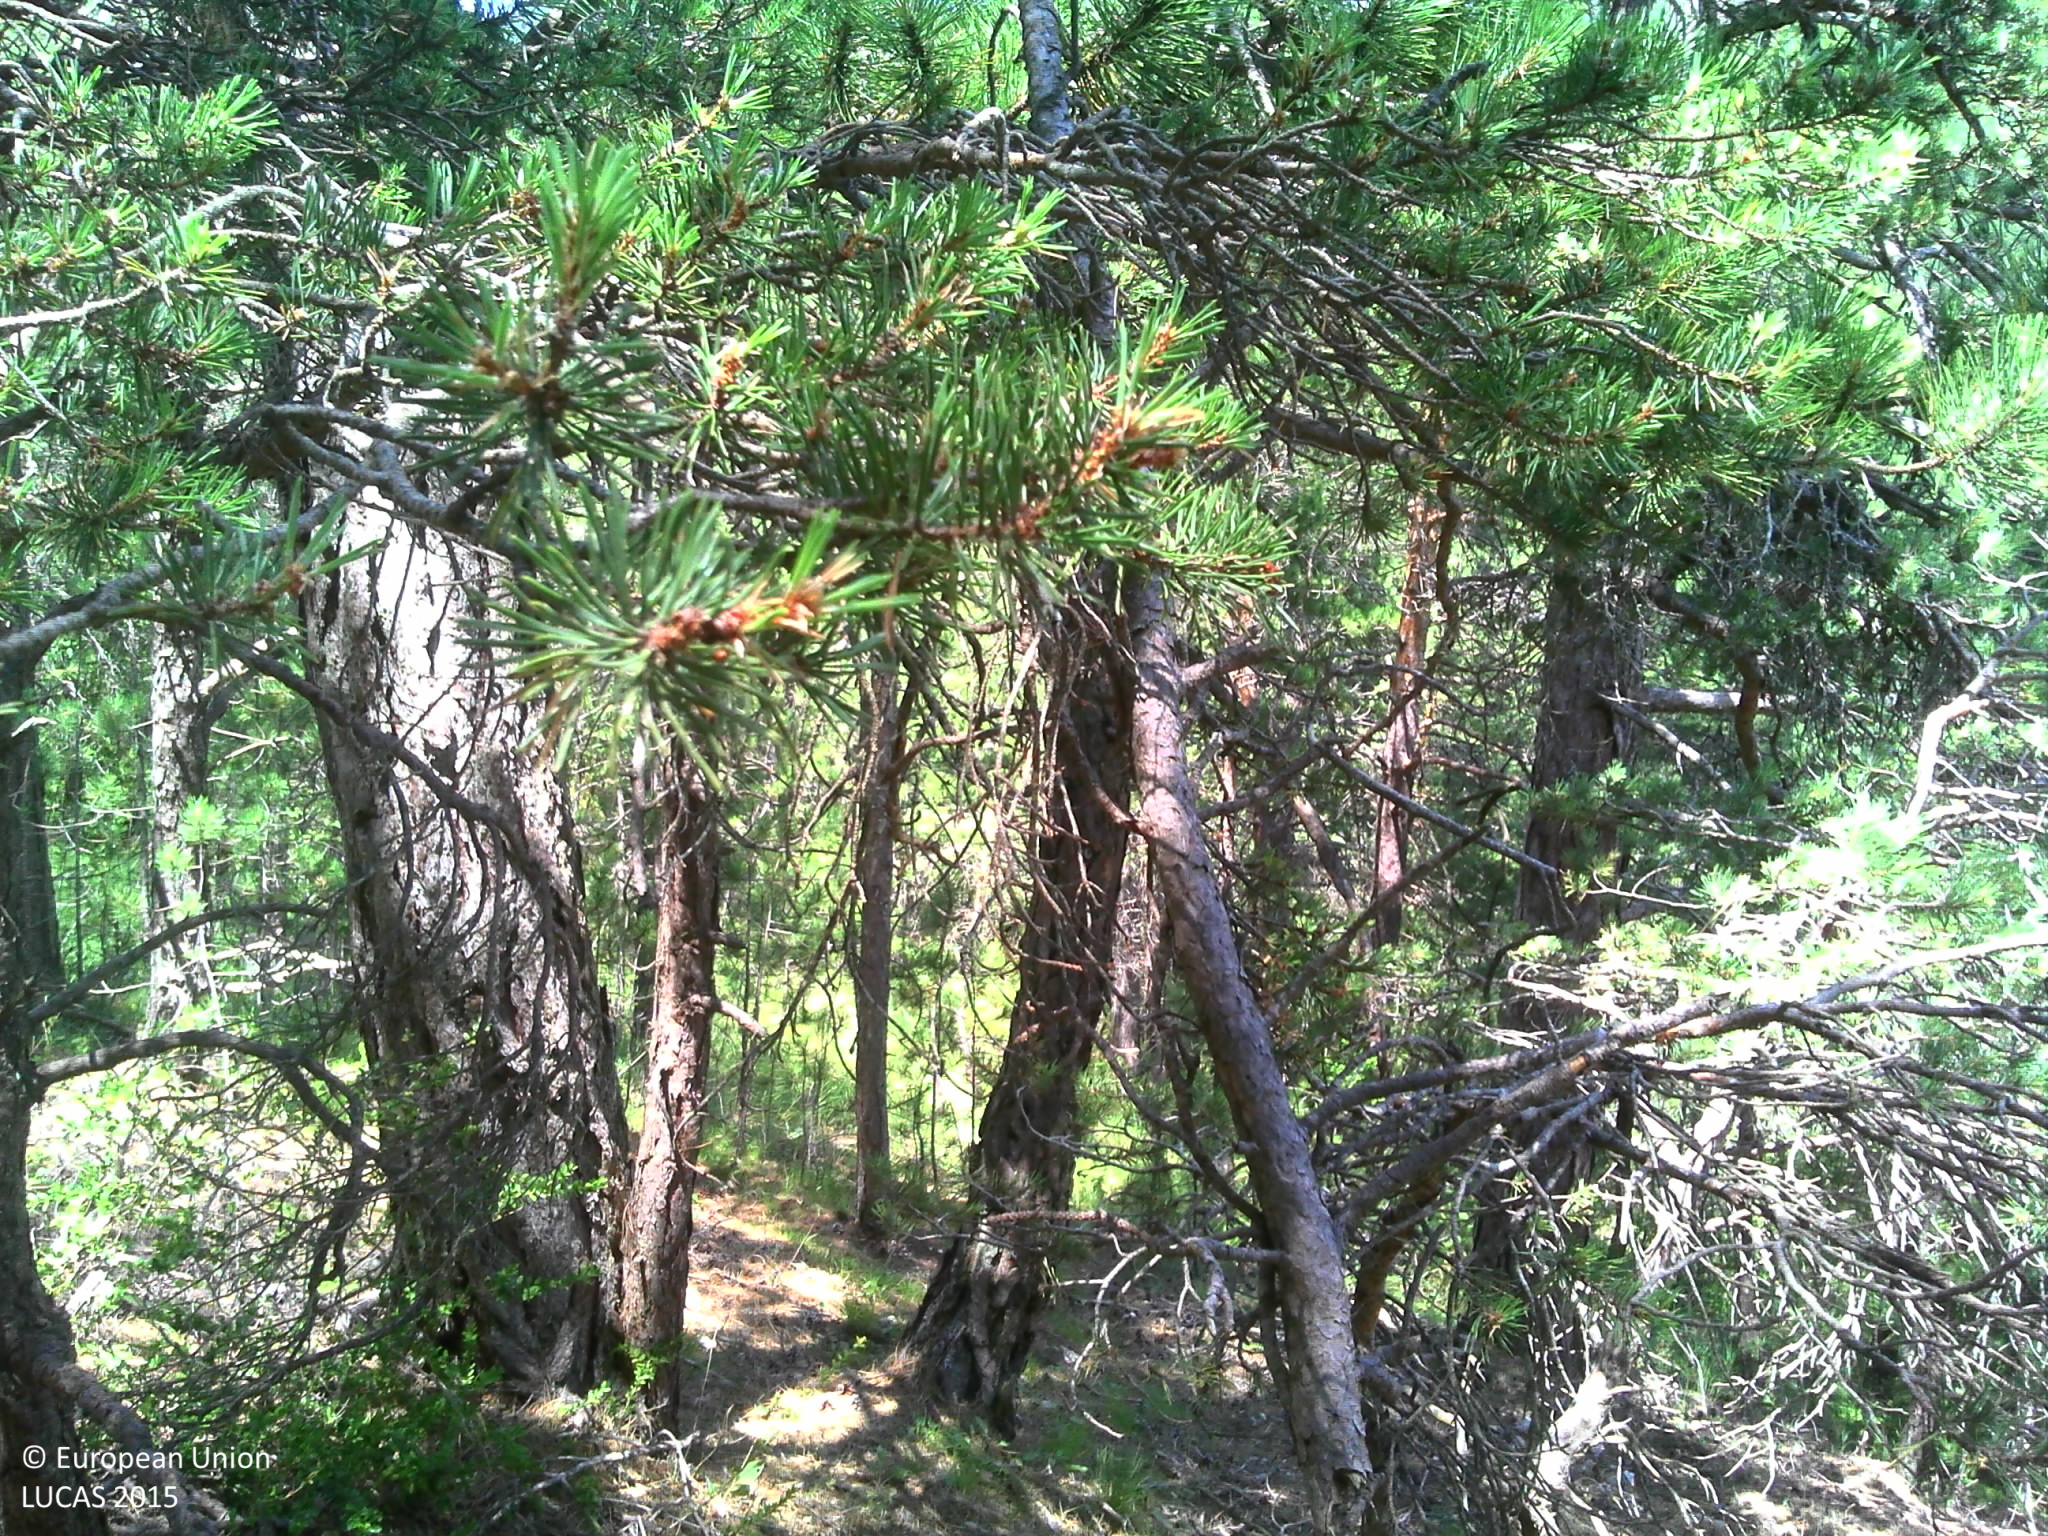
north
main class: Woodland
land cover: Pine dominated coniferous woodland
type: coniferous forest of the mediterranean region
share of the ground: > 75 %
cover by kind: coniferous forest trees 100 %
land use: Forestry
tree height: > 5 m
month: July
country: FR
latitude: 44.8047
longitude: 5.3157
